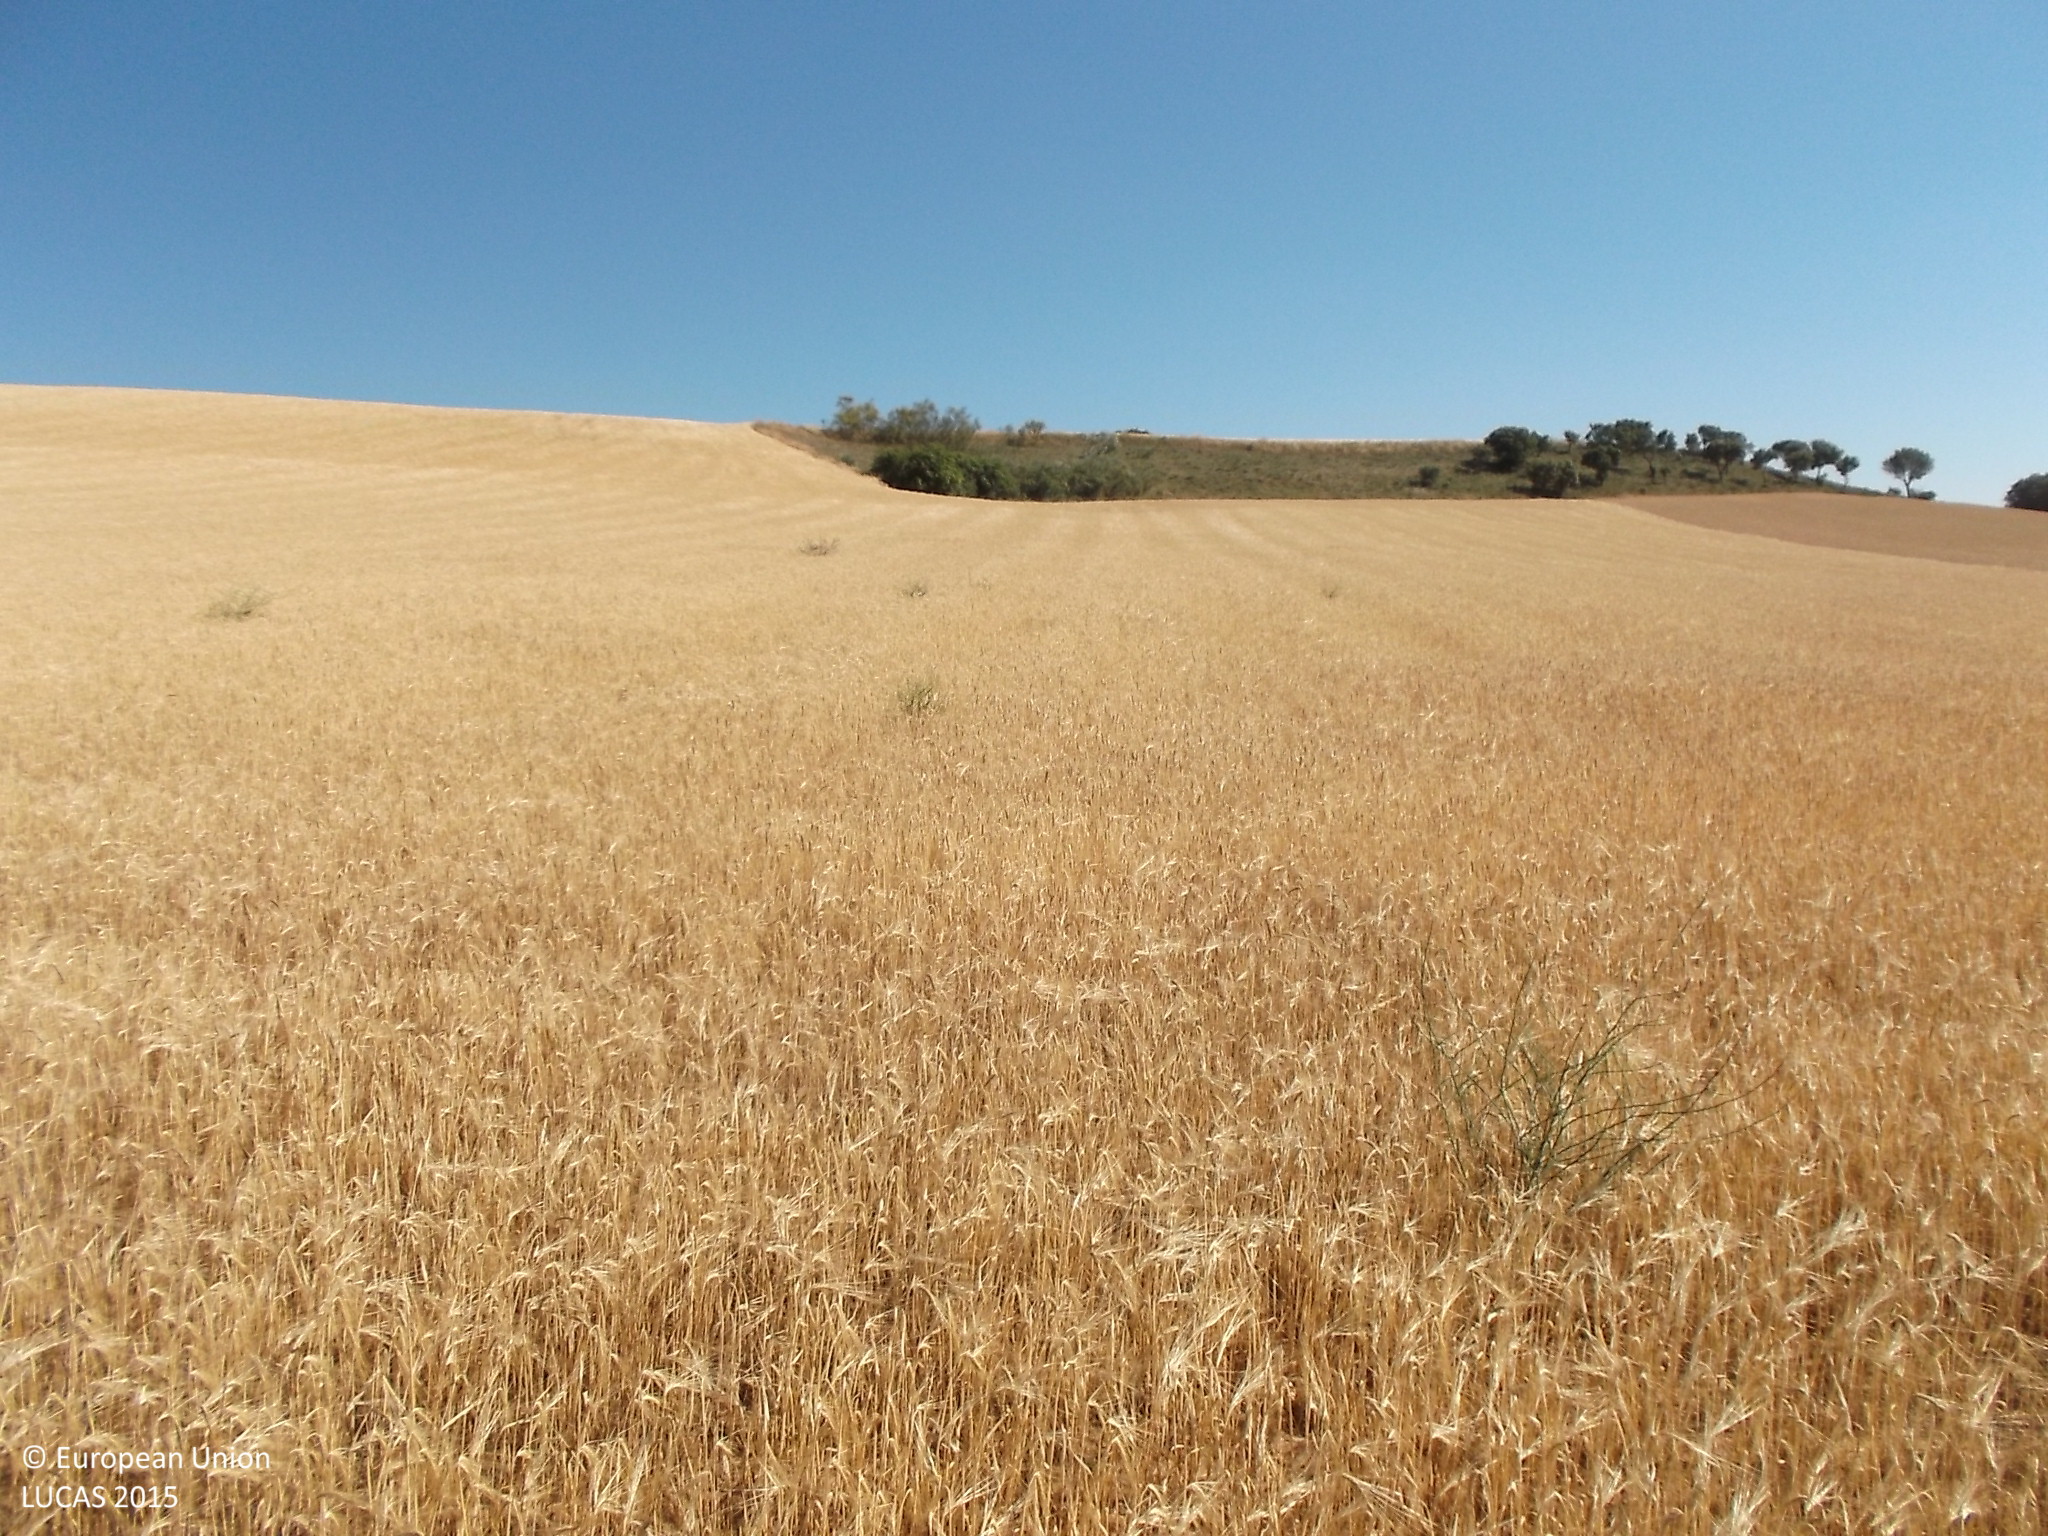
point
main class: Cropland
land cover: Barley
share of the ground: > 75 %
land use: Agriculture (excluding fallow land and kitchen gardens)
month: June
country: ES
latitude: 41.3315
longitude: -5.3343
